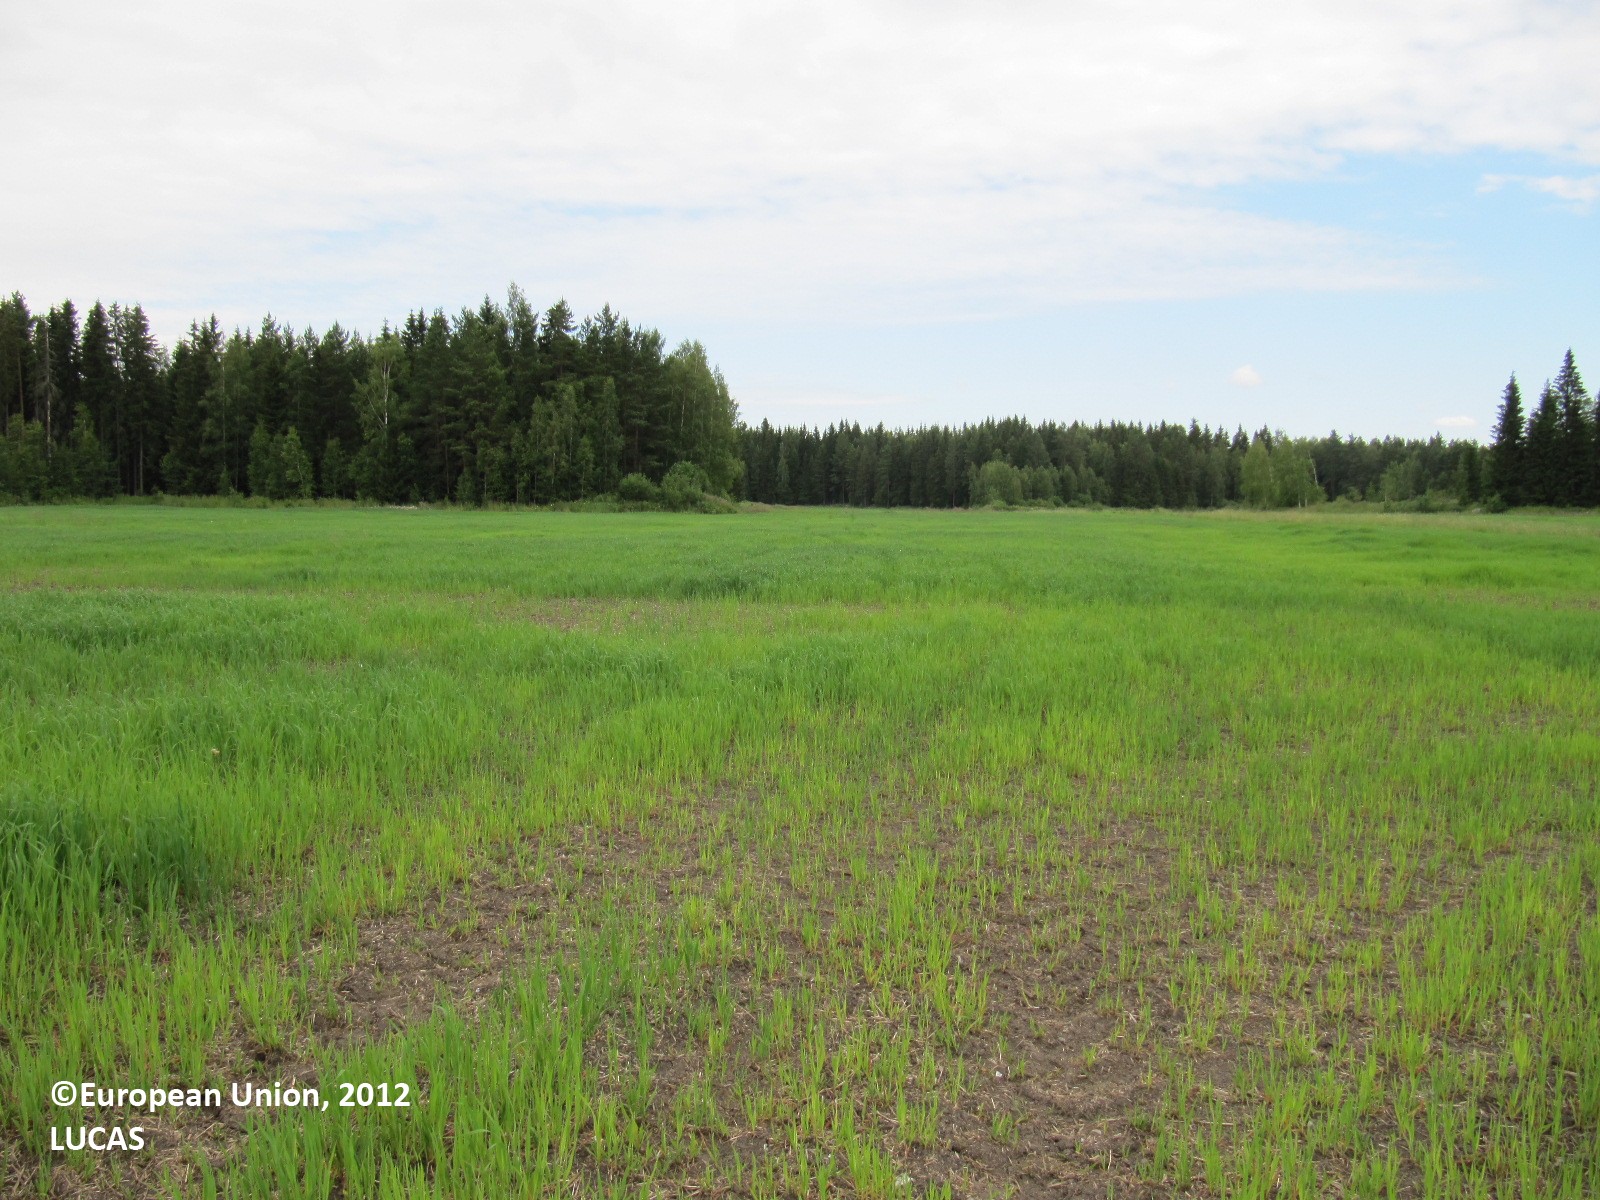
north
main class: Cropland
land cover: Oats
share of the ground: 50 - 75 %
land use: Agriculture (excluding fallow land and kitchen gardens)
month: July
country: FI
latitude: 60.9057
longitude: 23.4492
